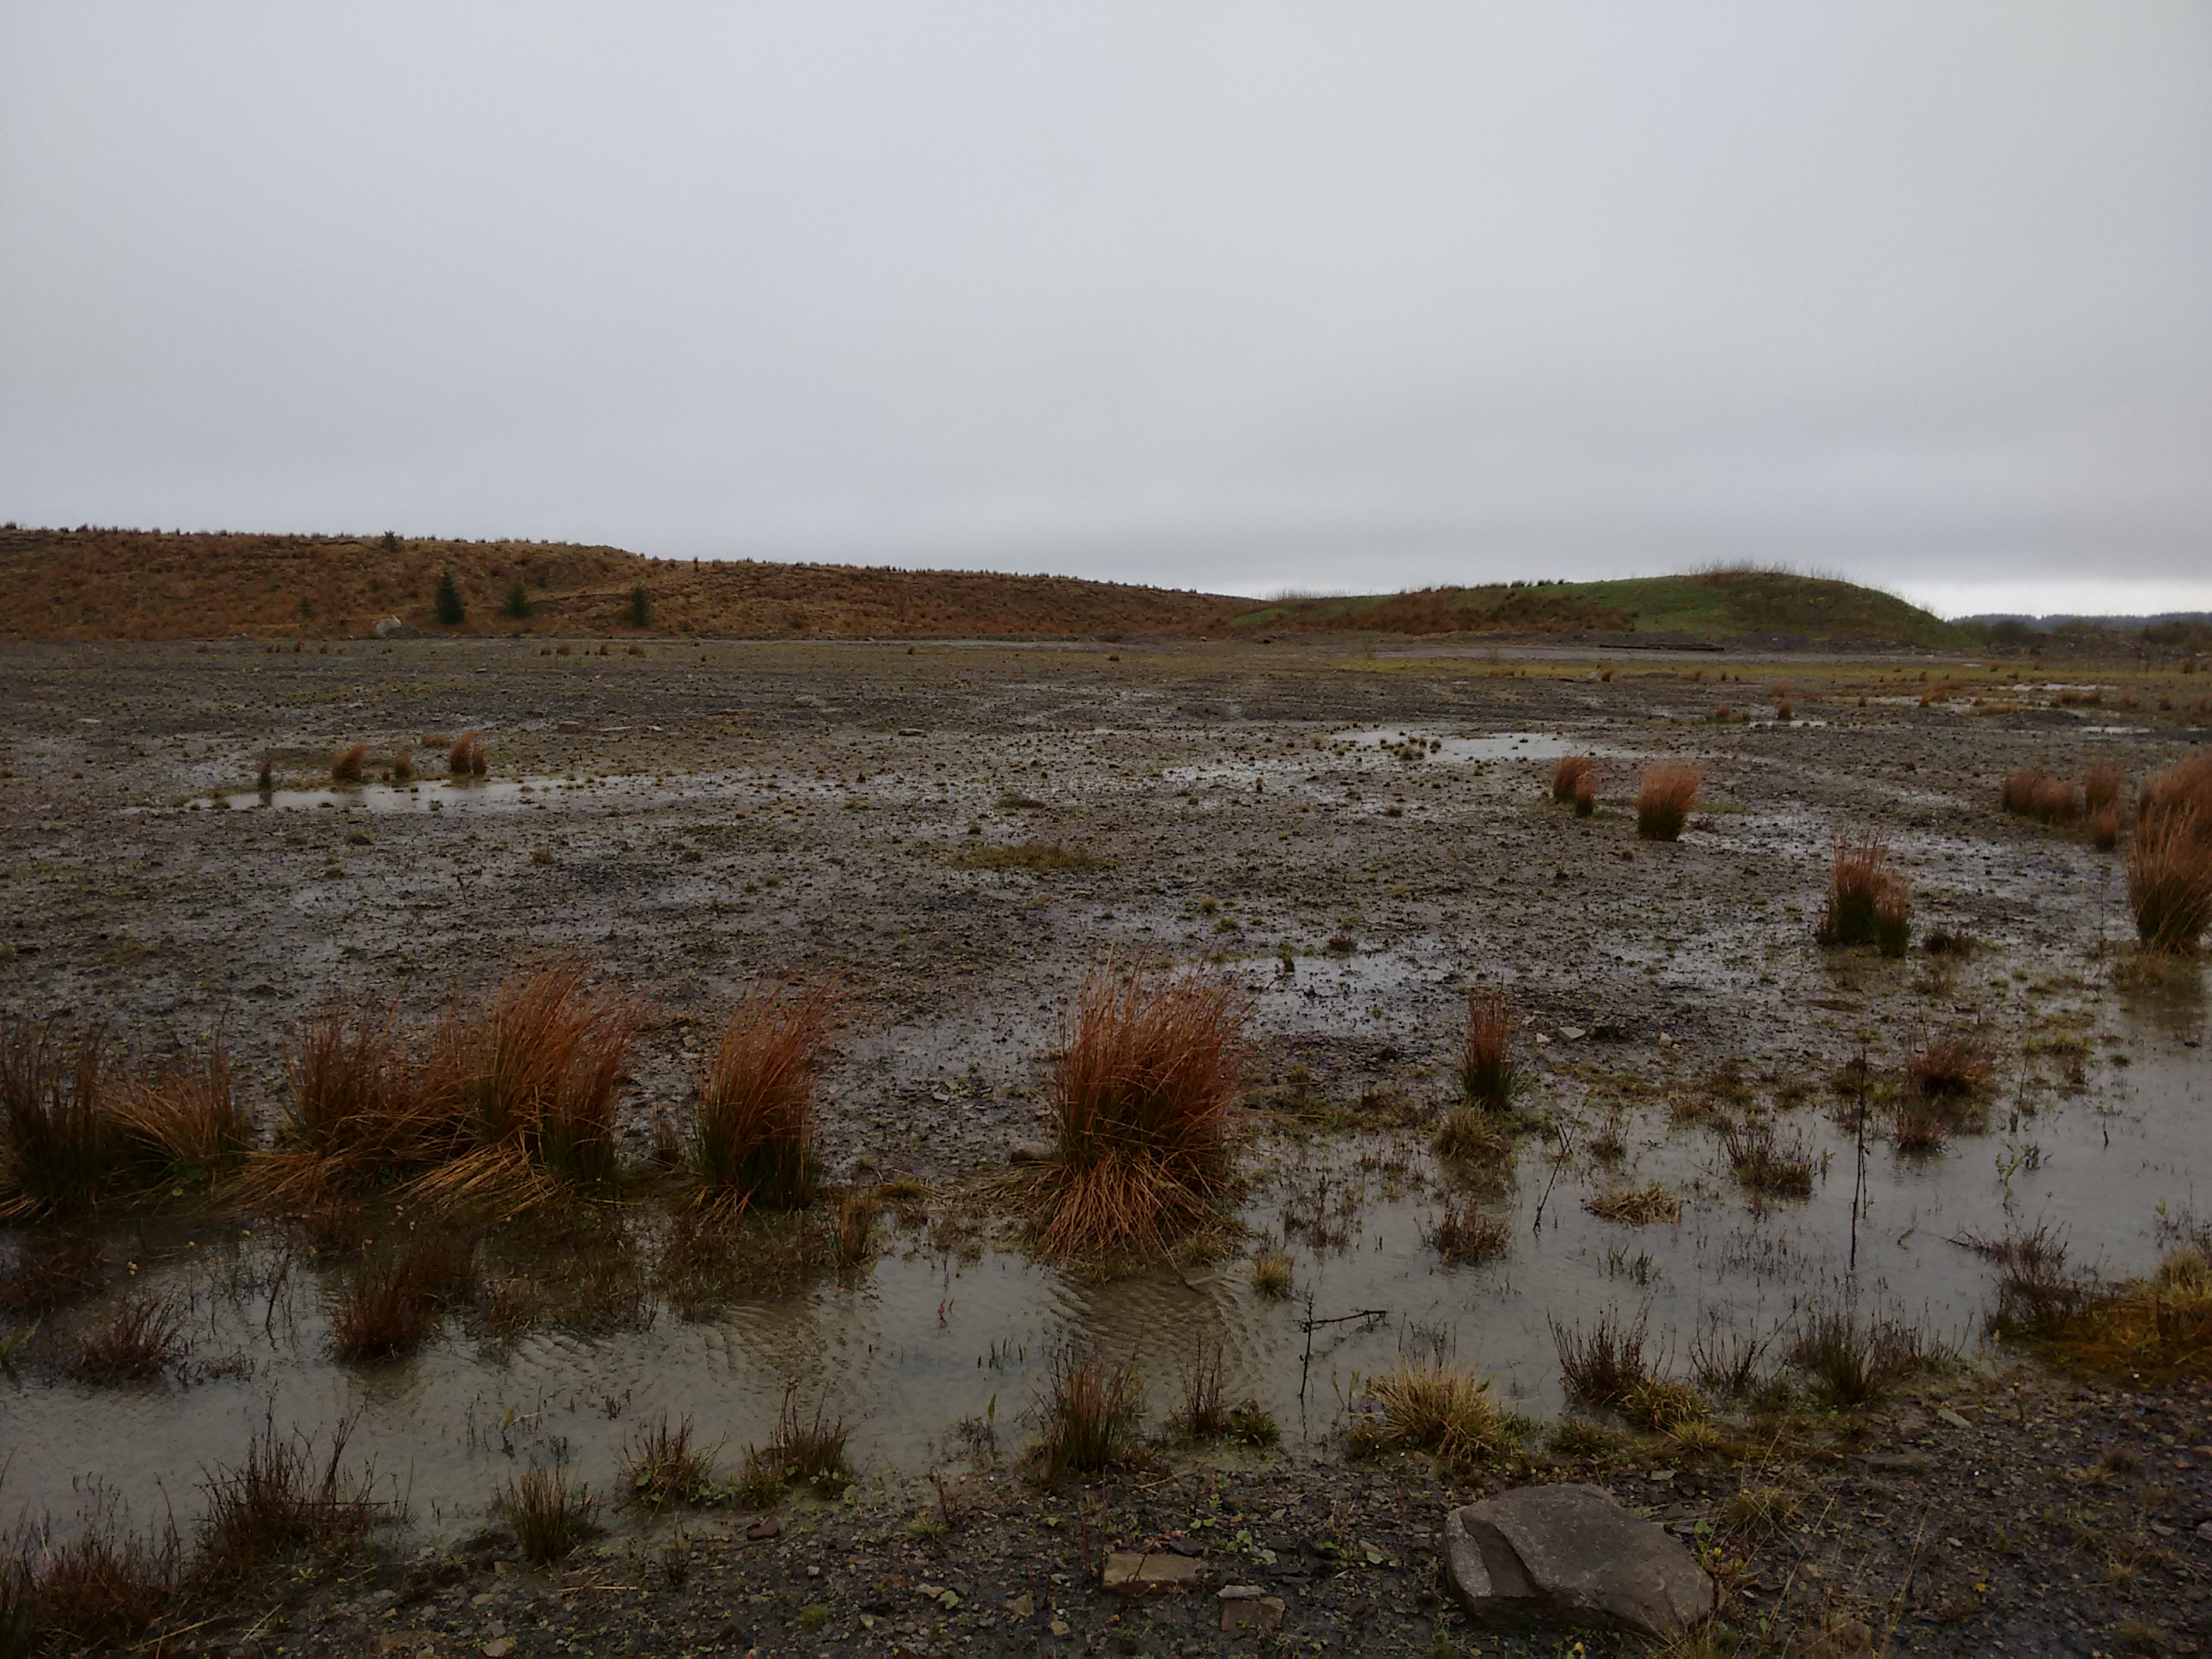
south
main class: Grassland
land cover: Spontaneously vegetated surfaces
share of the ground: > 75 %
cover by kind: herbaceous plants 50 %, unconsolidated bare surface 50 %
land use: Abandoned areas
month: May
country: GB
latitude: 55.8040
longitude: -3.7881
